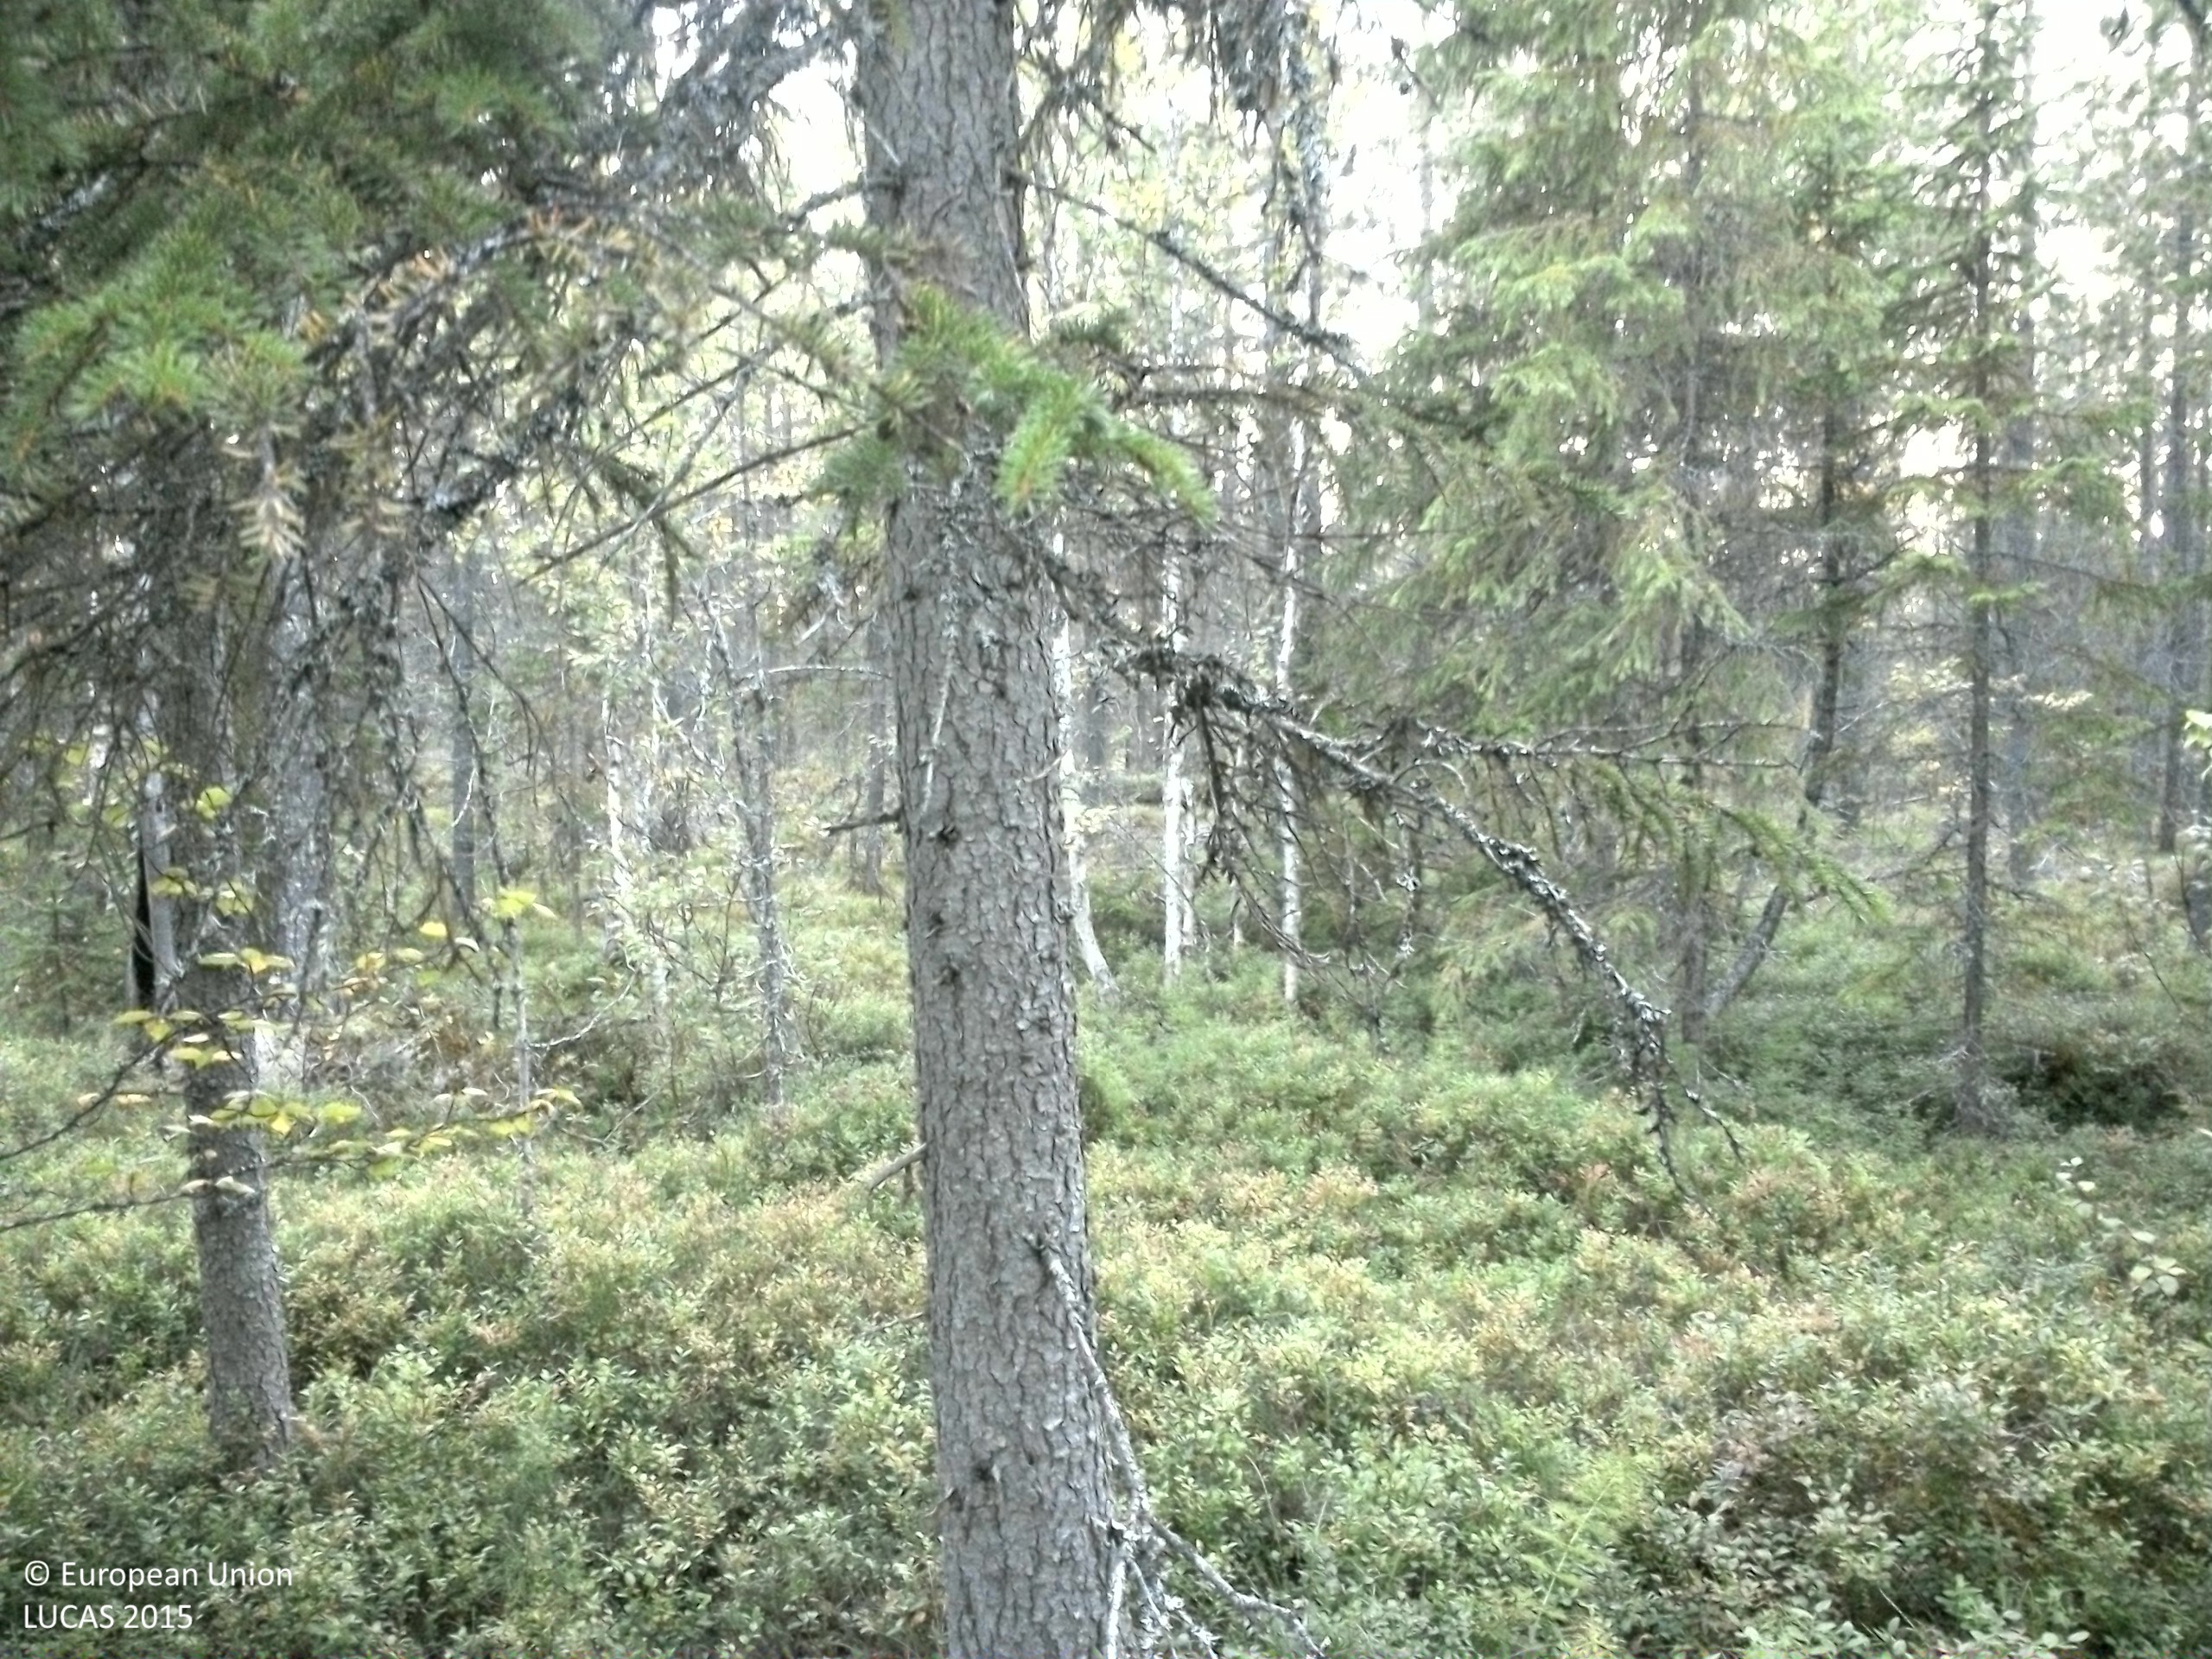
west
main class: Woodland
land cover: Other mixed woodland
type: boreal forest
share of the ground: 50 - 75 %
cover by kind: coniferous forest trees 45 %, shrubs 30 %, broadleaved forest trees 15 %, lichens and mosses 10 %
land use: Forestry
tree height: > 5 m
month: September
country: SE
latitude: 63.8953
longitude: 16.6730
